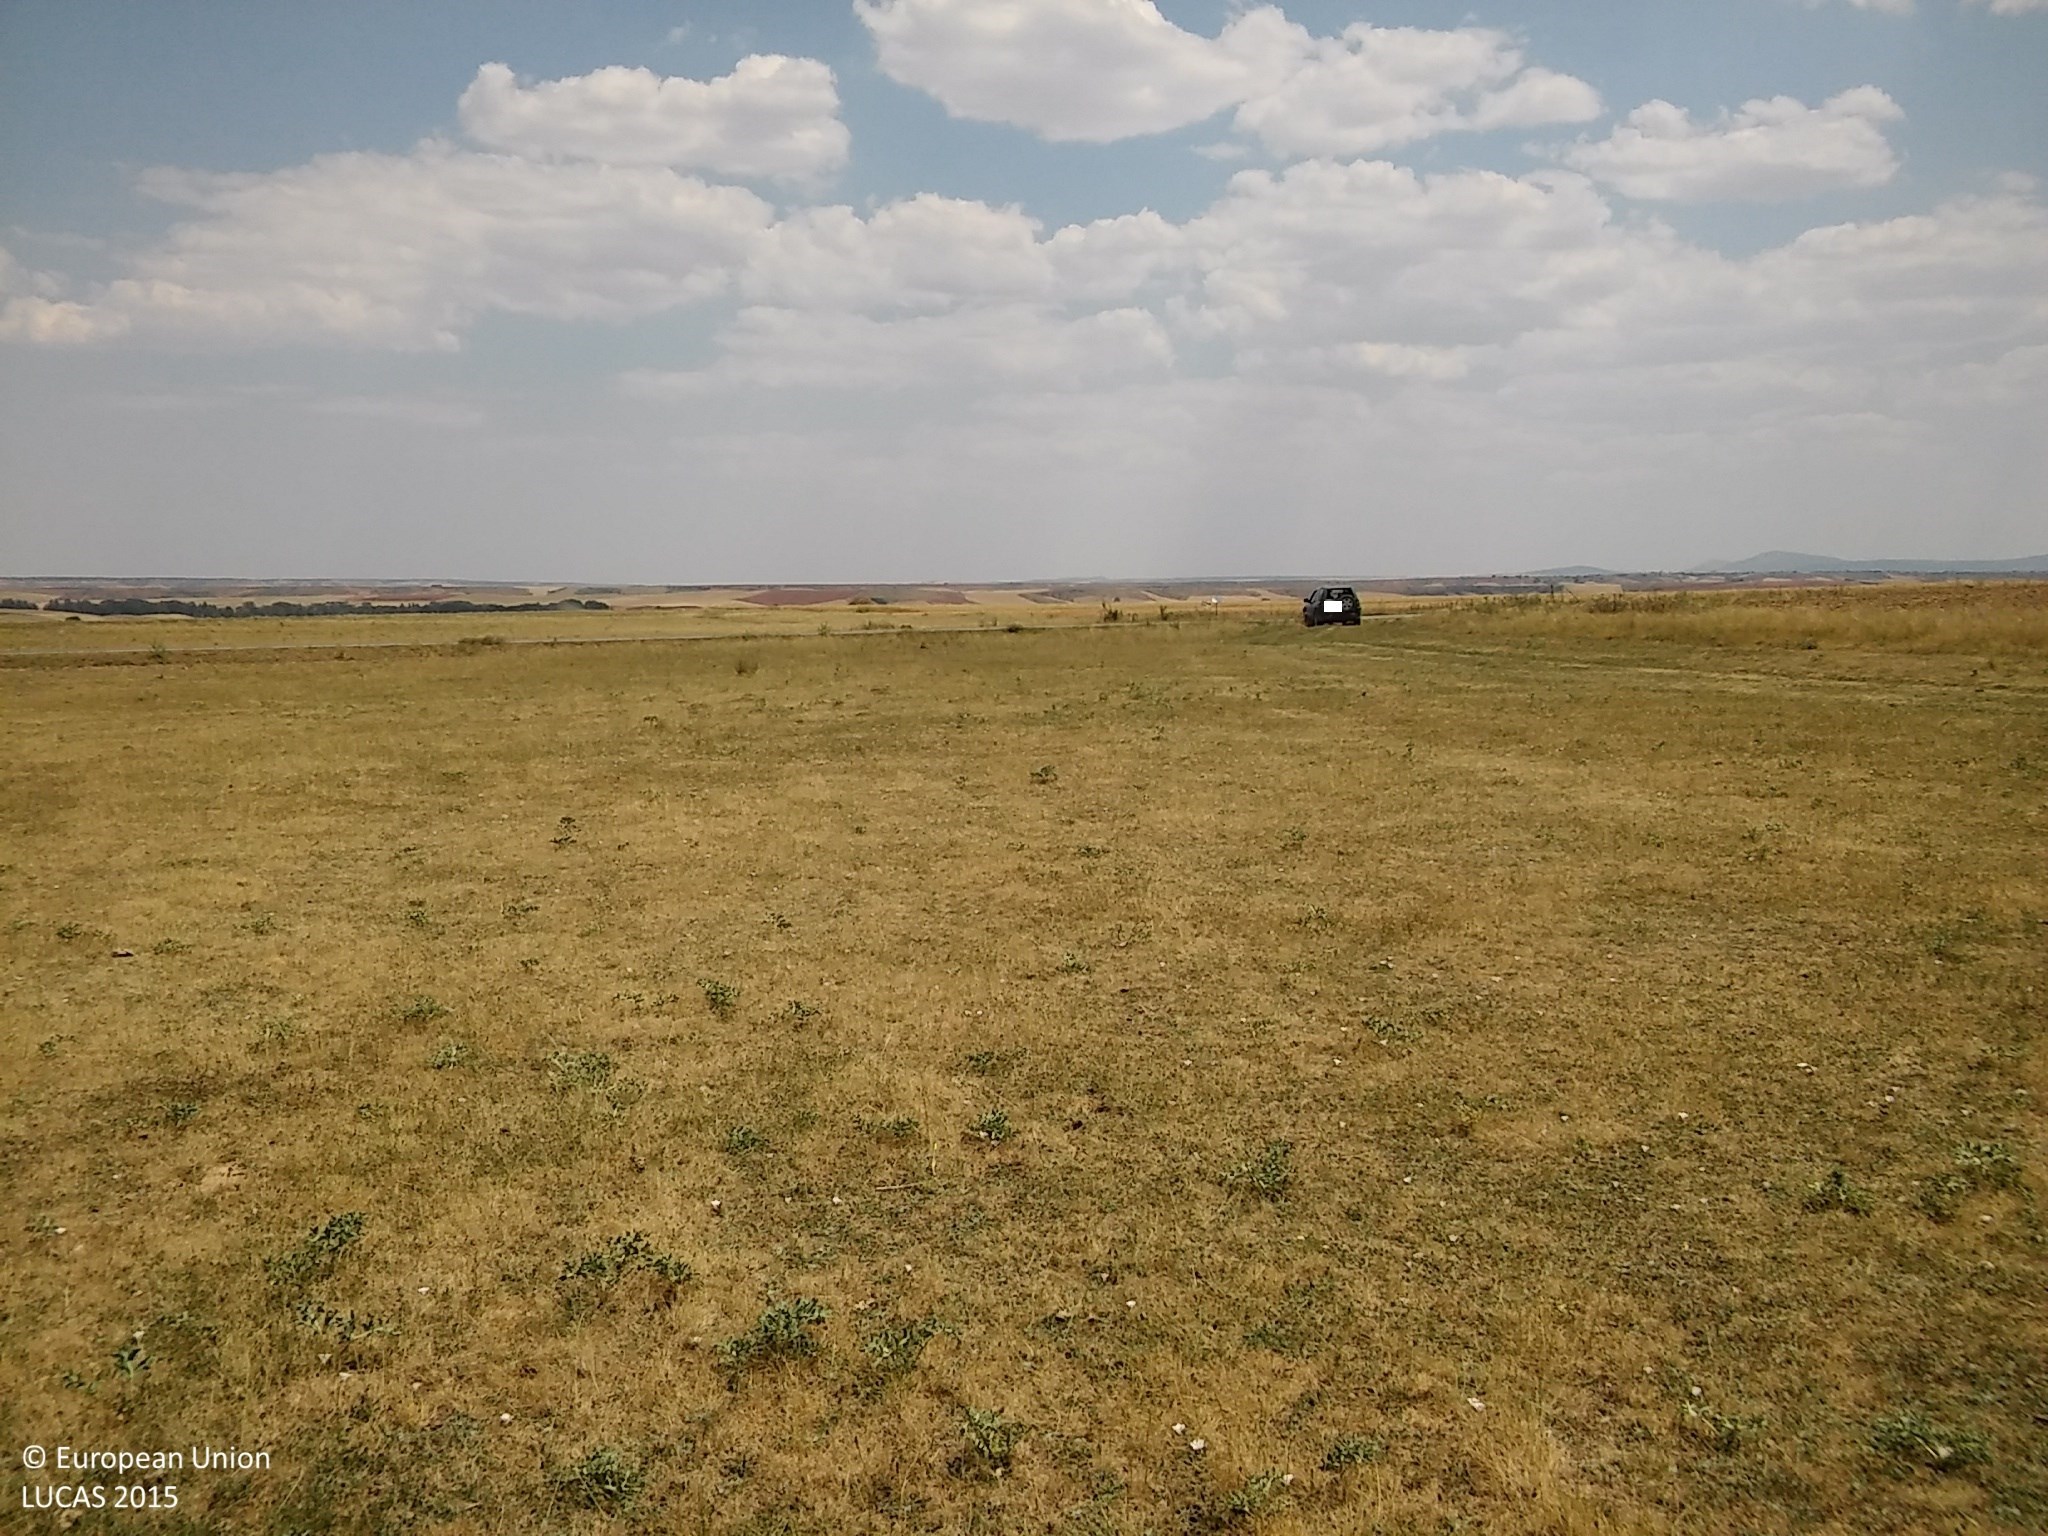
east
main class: Grassland
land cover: Grassland without tree/shrub cover
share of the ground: > 75 %
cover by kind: herbaceous plants 100 %
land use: Agriculture (excluding fallow land and kitchen gardens)
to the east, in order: Grassland without tree/shrub cover; Ditches and canals; Grass margins; Paved roads, cycling and walking lanes; Grass margins; Ditches and canals; Grassland without tree/shrub cover; Common wheat
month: June
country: ES
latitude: 41.4123
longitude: -3.5302
